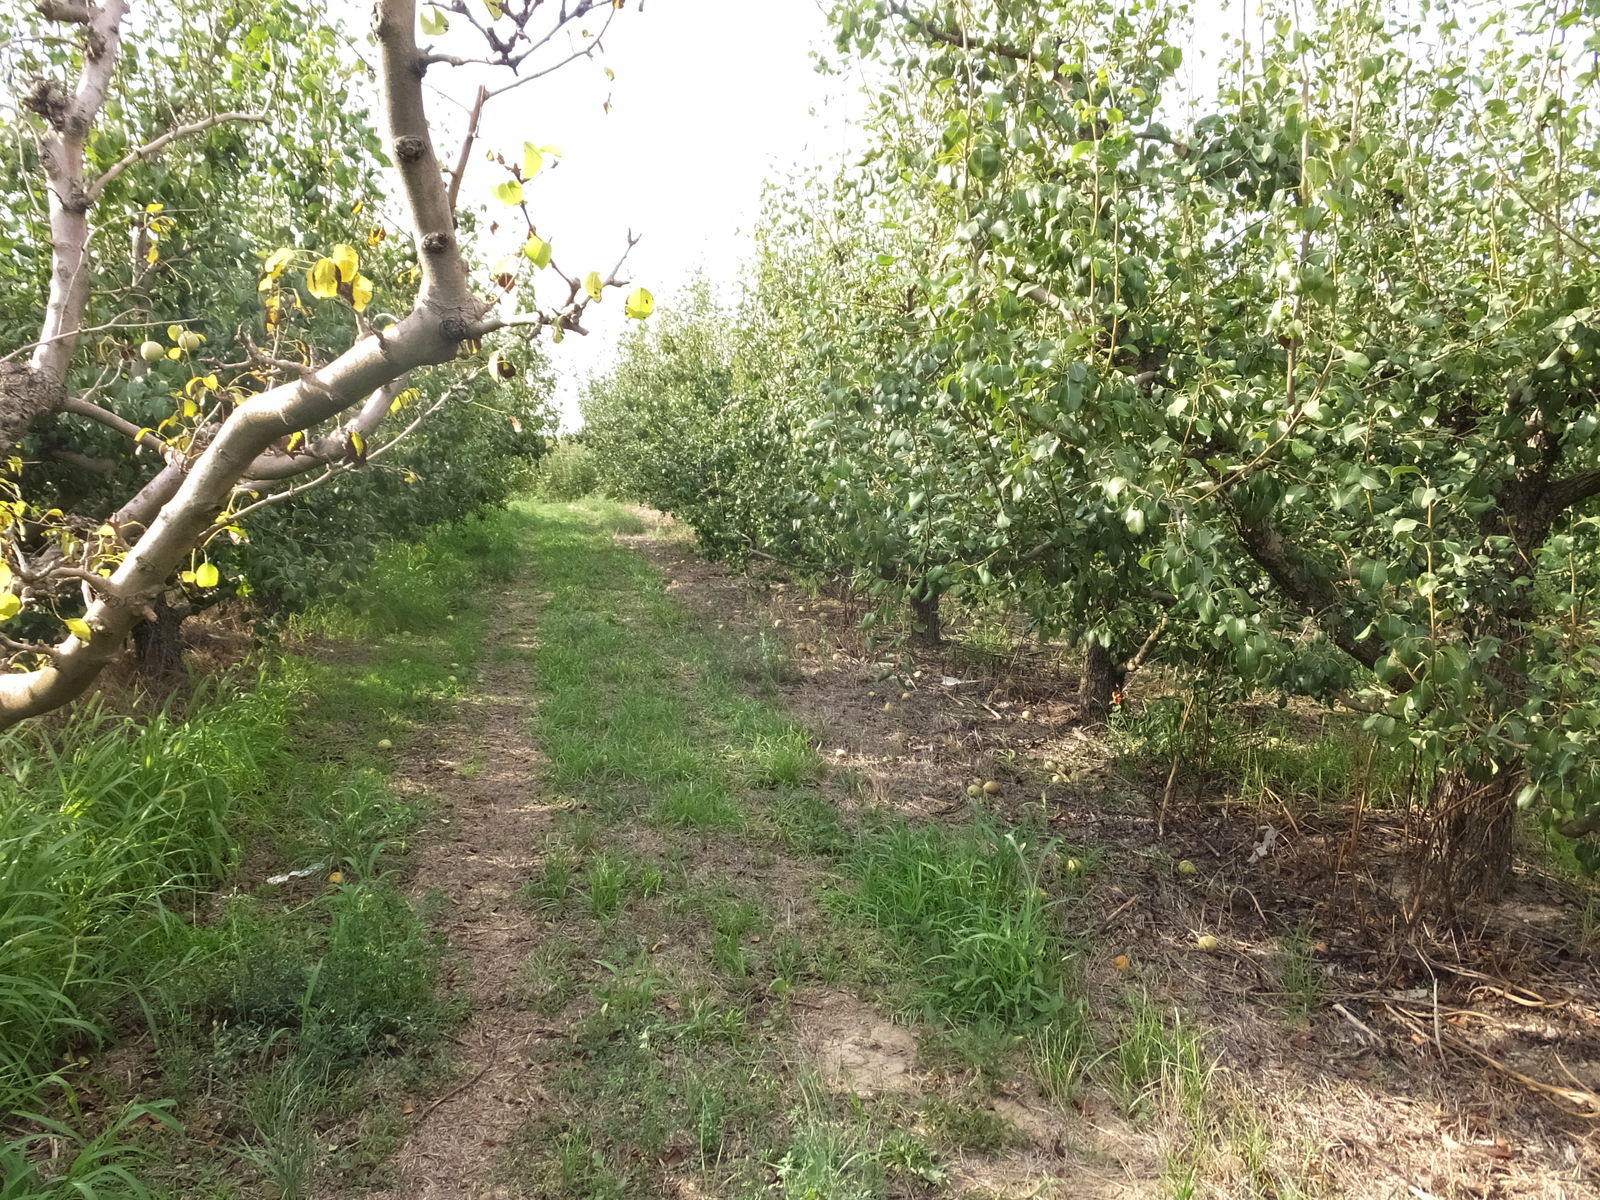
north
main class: Cropland
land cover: Pear fruit
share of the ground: > 75 %
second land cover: Spontaneously vegetated surfaces
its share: 10 - 25 %
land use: Agriculture (excluding fallow land and kitchen gardens)
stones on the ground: < 10 %
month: August
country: ES
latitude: 41.5278
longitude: 0.4358
